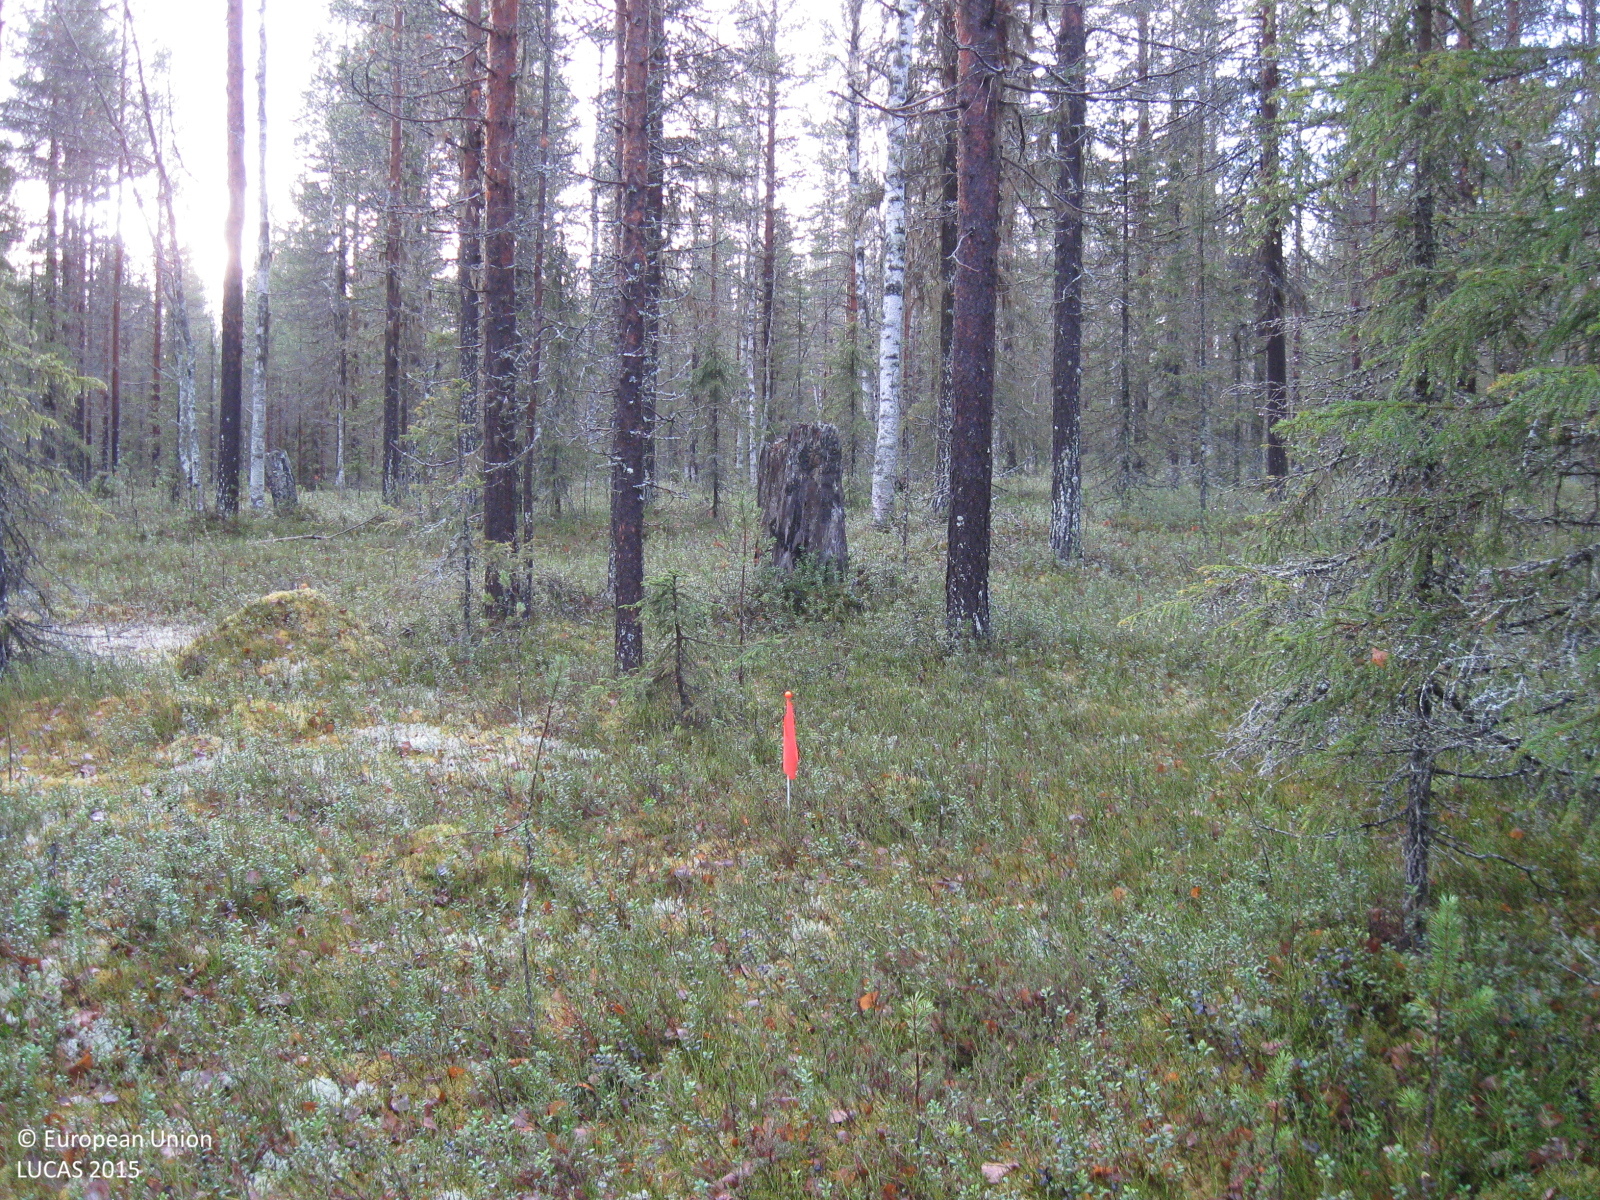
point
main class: Woodland
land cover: Pine dominated coniferous woodland
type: boreal forest
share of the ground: 50 - 75 %
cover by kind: coniferous forest trees 60 %, broadleaved forest trees 15 %, shrubs 10 %, lichens and mosses 10 %, herbaceous plants 5 %
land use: Forestry
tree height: > 5 m
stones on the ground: > 50 %
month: October
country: SE
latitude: 66.5082
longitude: 20.9068
